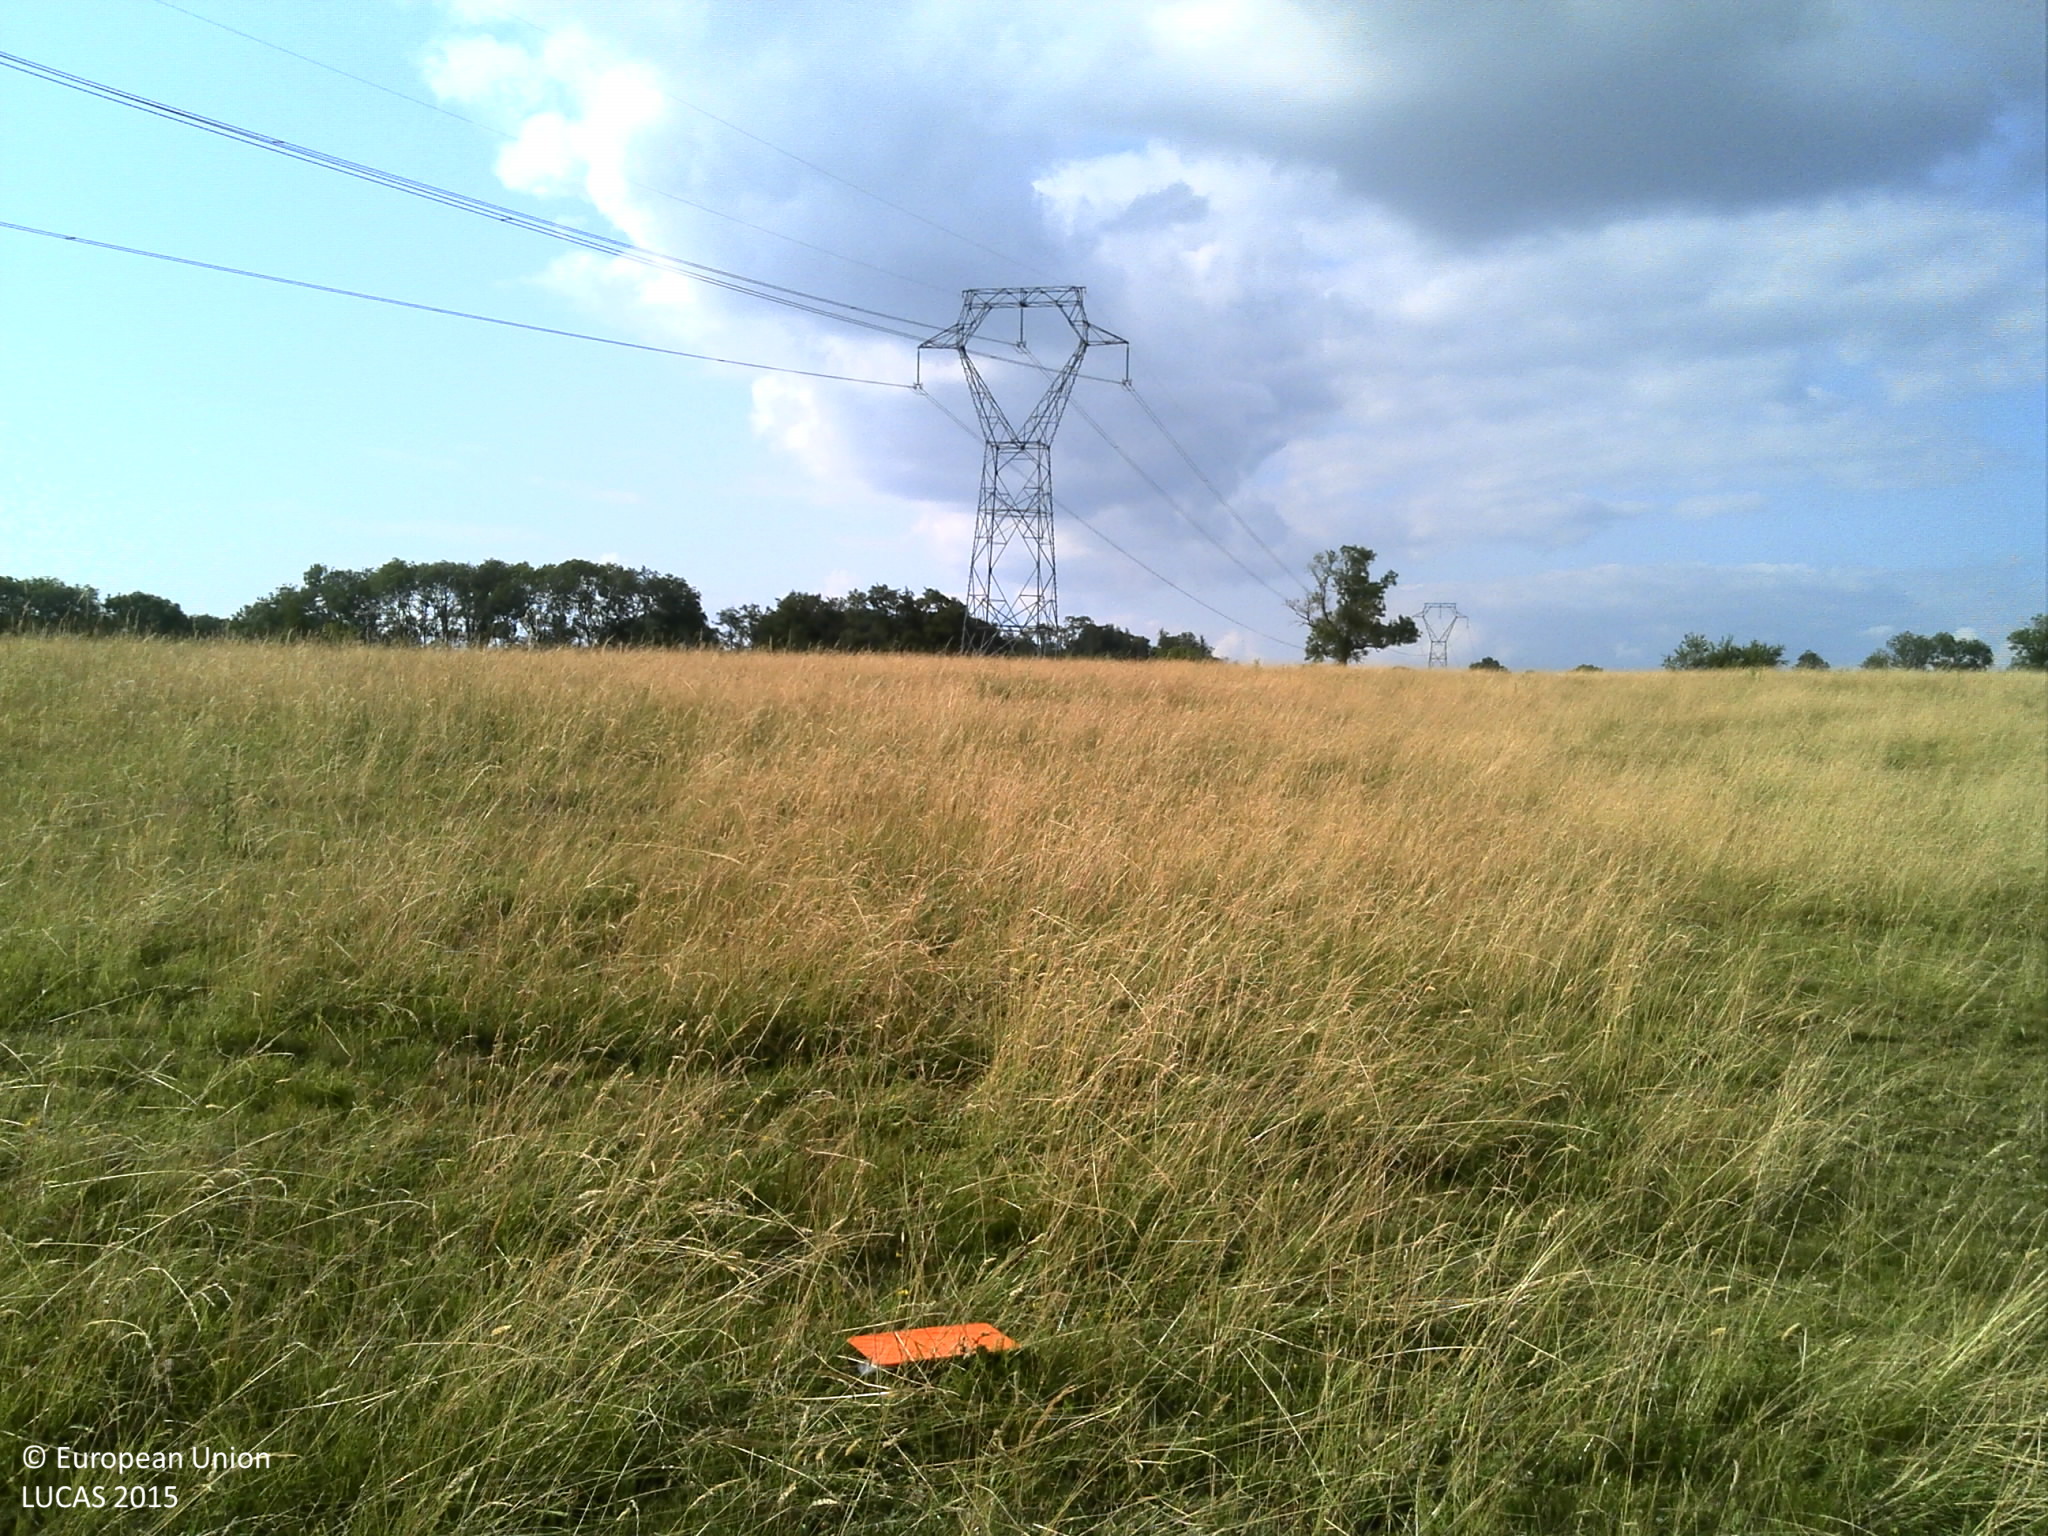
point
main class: Grassland
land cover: Grassland without tree/shrub cover
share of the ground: > 75 %
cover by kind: herbaceous plants 100 %
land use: Agriculture (excluding fallow land and kitchen gardens)
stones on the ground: < 10 %
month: July
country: FR
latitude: 49.6369
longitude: 4.4990
